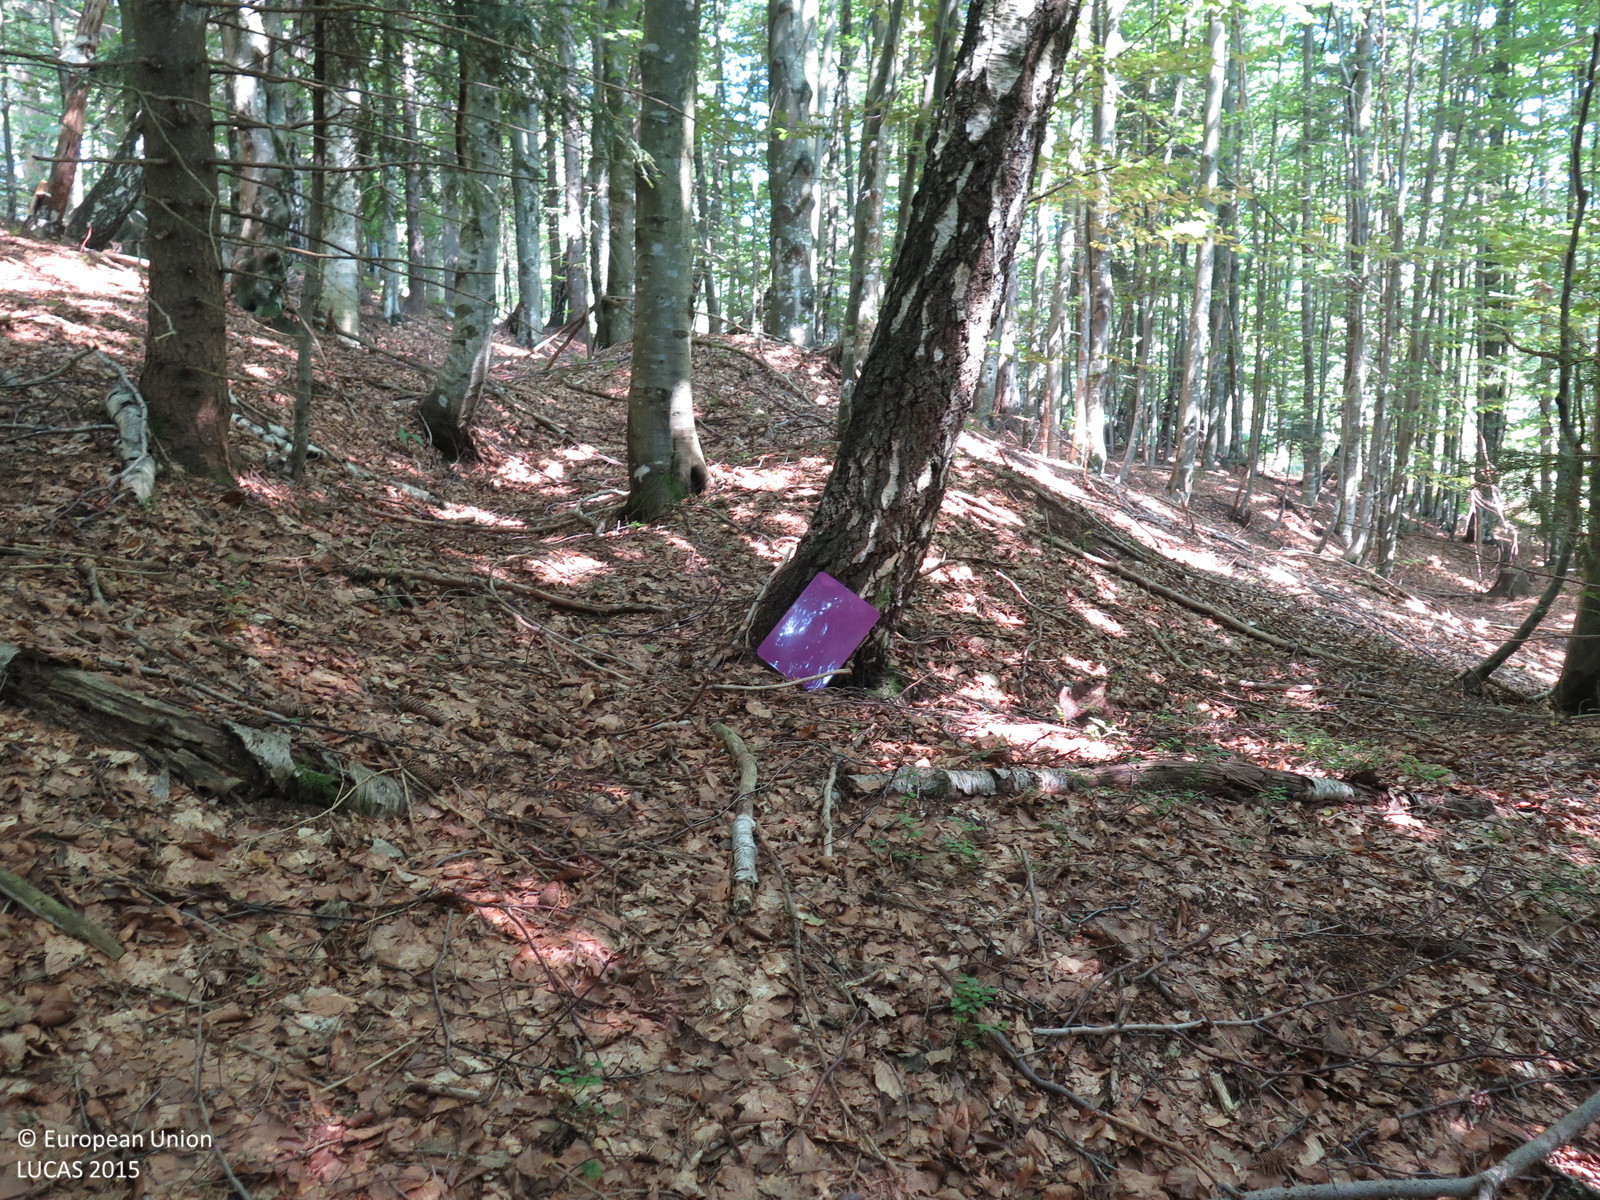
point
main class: Woodland
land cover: Other mixed woodland
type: beech forest
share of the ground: > 75 %
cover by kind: broadleaved forest trees 75 %, coniferous forest trees 25 %
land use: Forestry
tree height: > 5 m
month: August
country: HR
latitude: 45.3877
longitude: 14.9638
